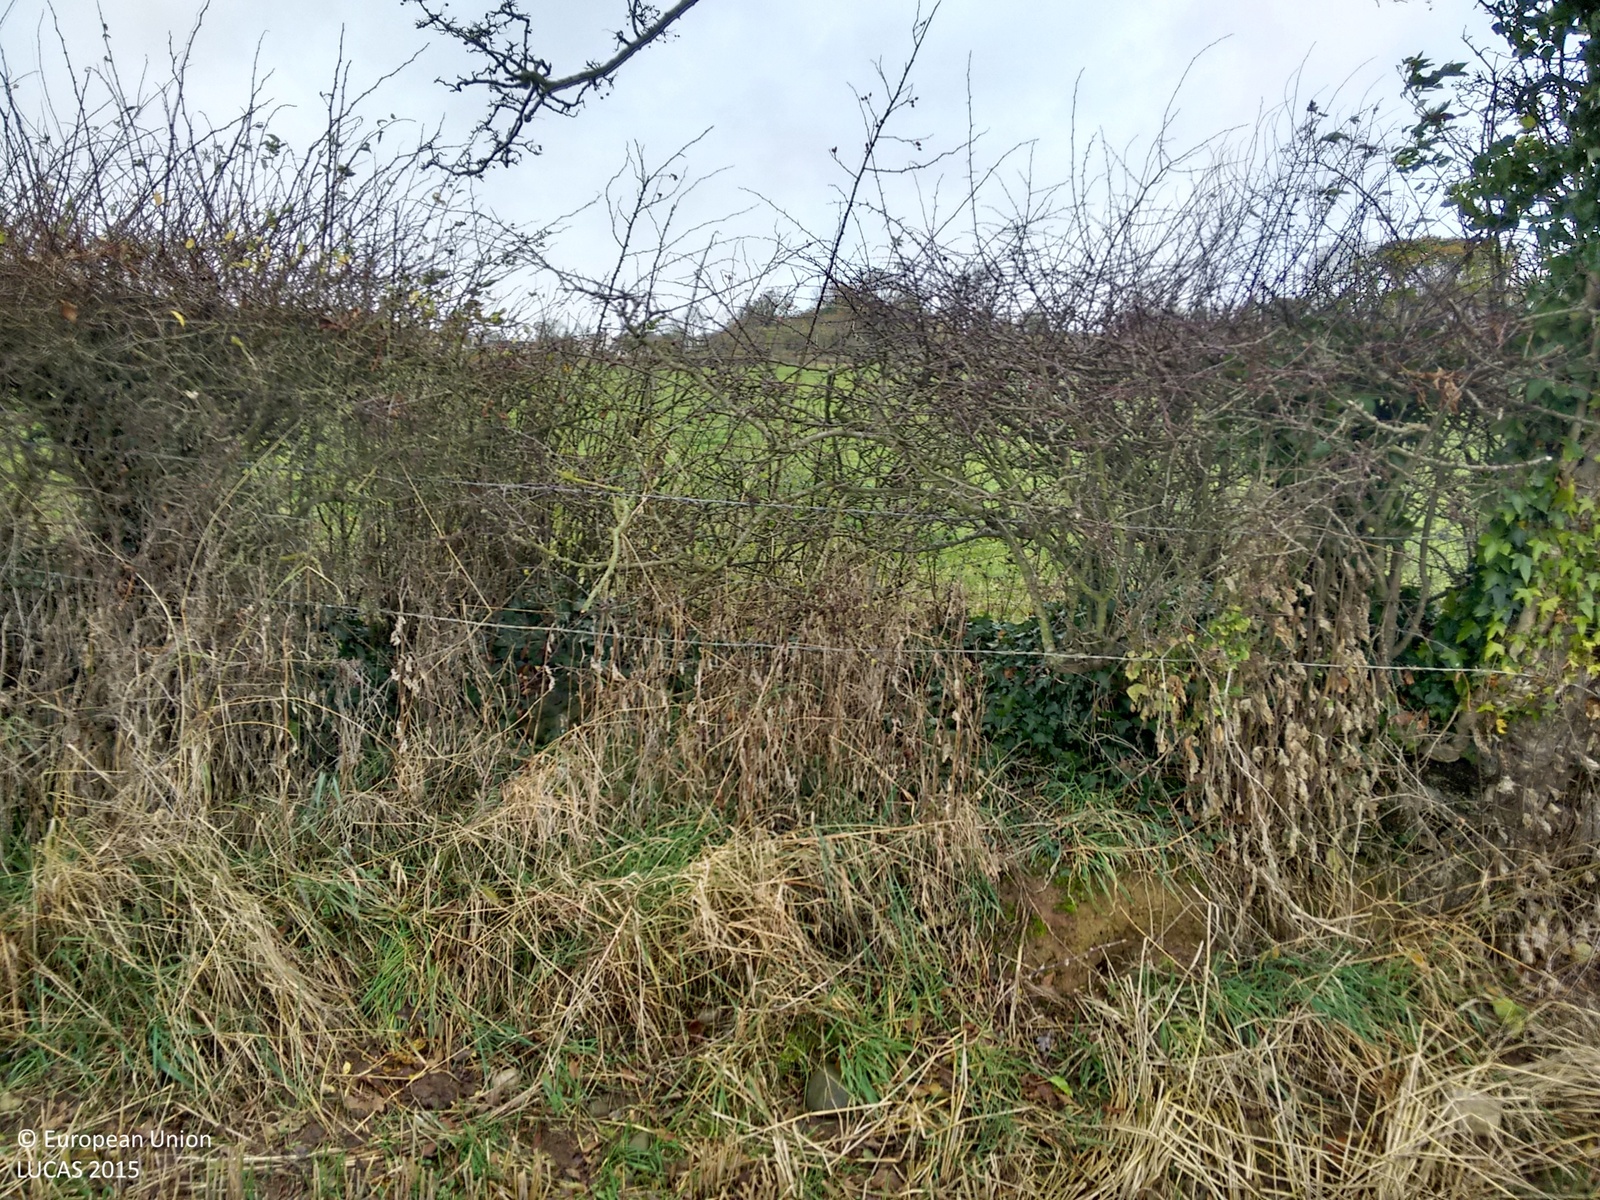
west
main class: Grassland
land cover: Grassland without tree/shrub cover
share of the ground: > 75 %
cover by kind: herbaceous plants 85 %, shrubs 5 %
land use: Agriculture (excluding fallow land and kitchen gardens)
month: November
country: IE
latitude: 53.1901
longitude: -7.6905
